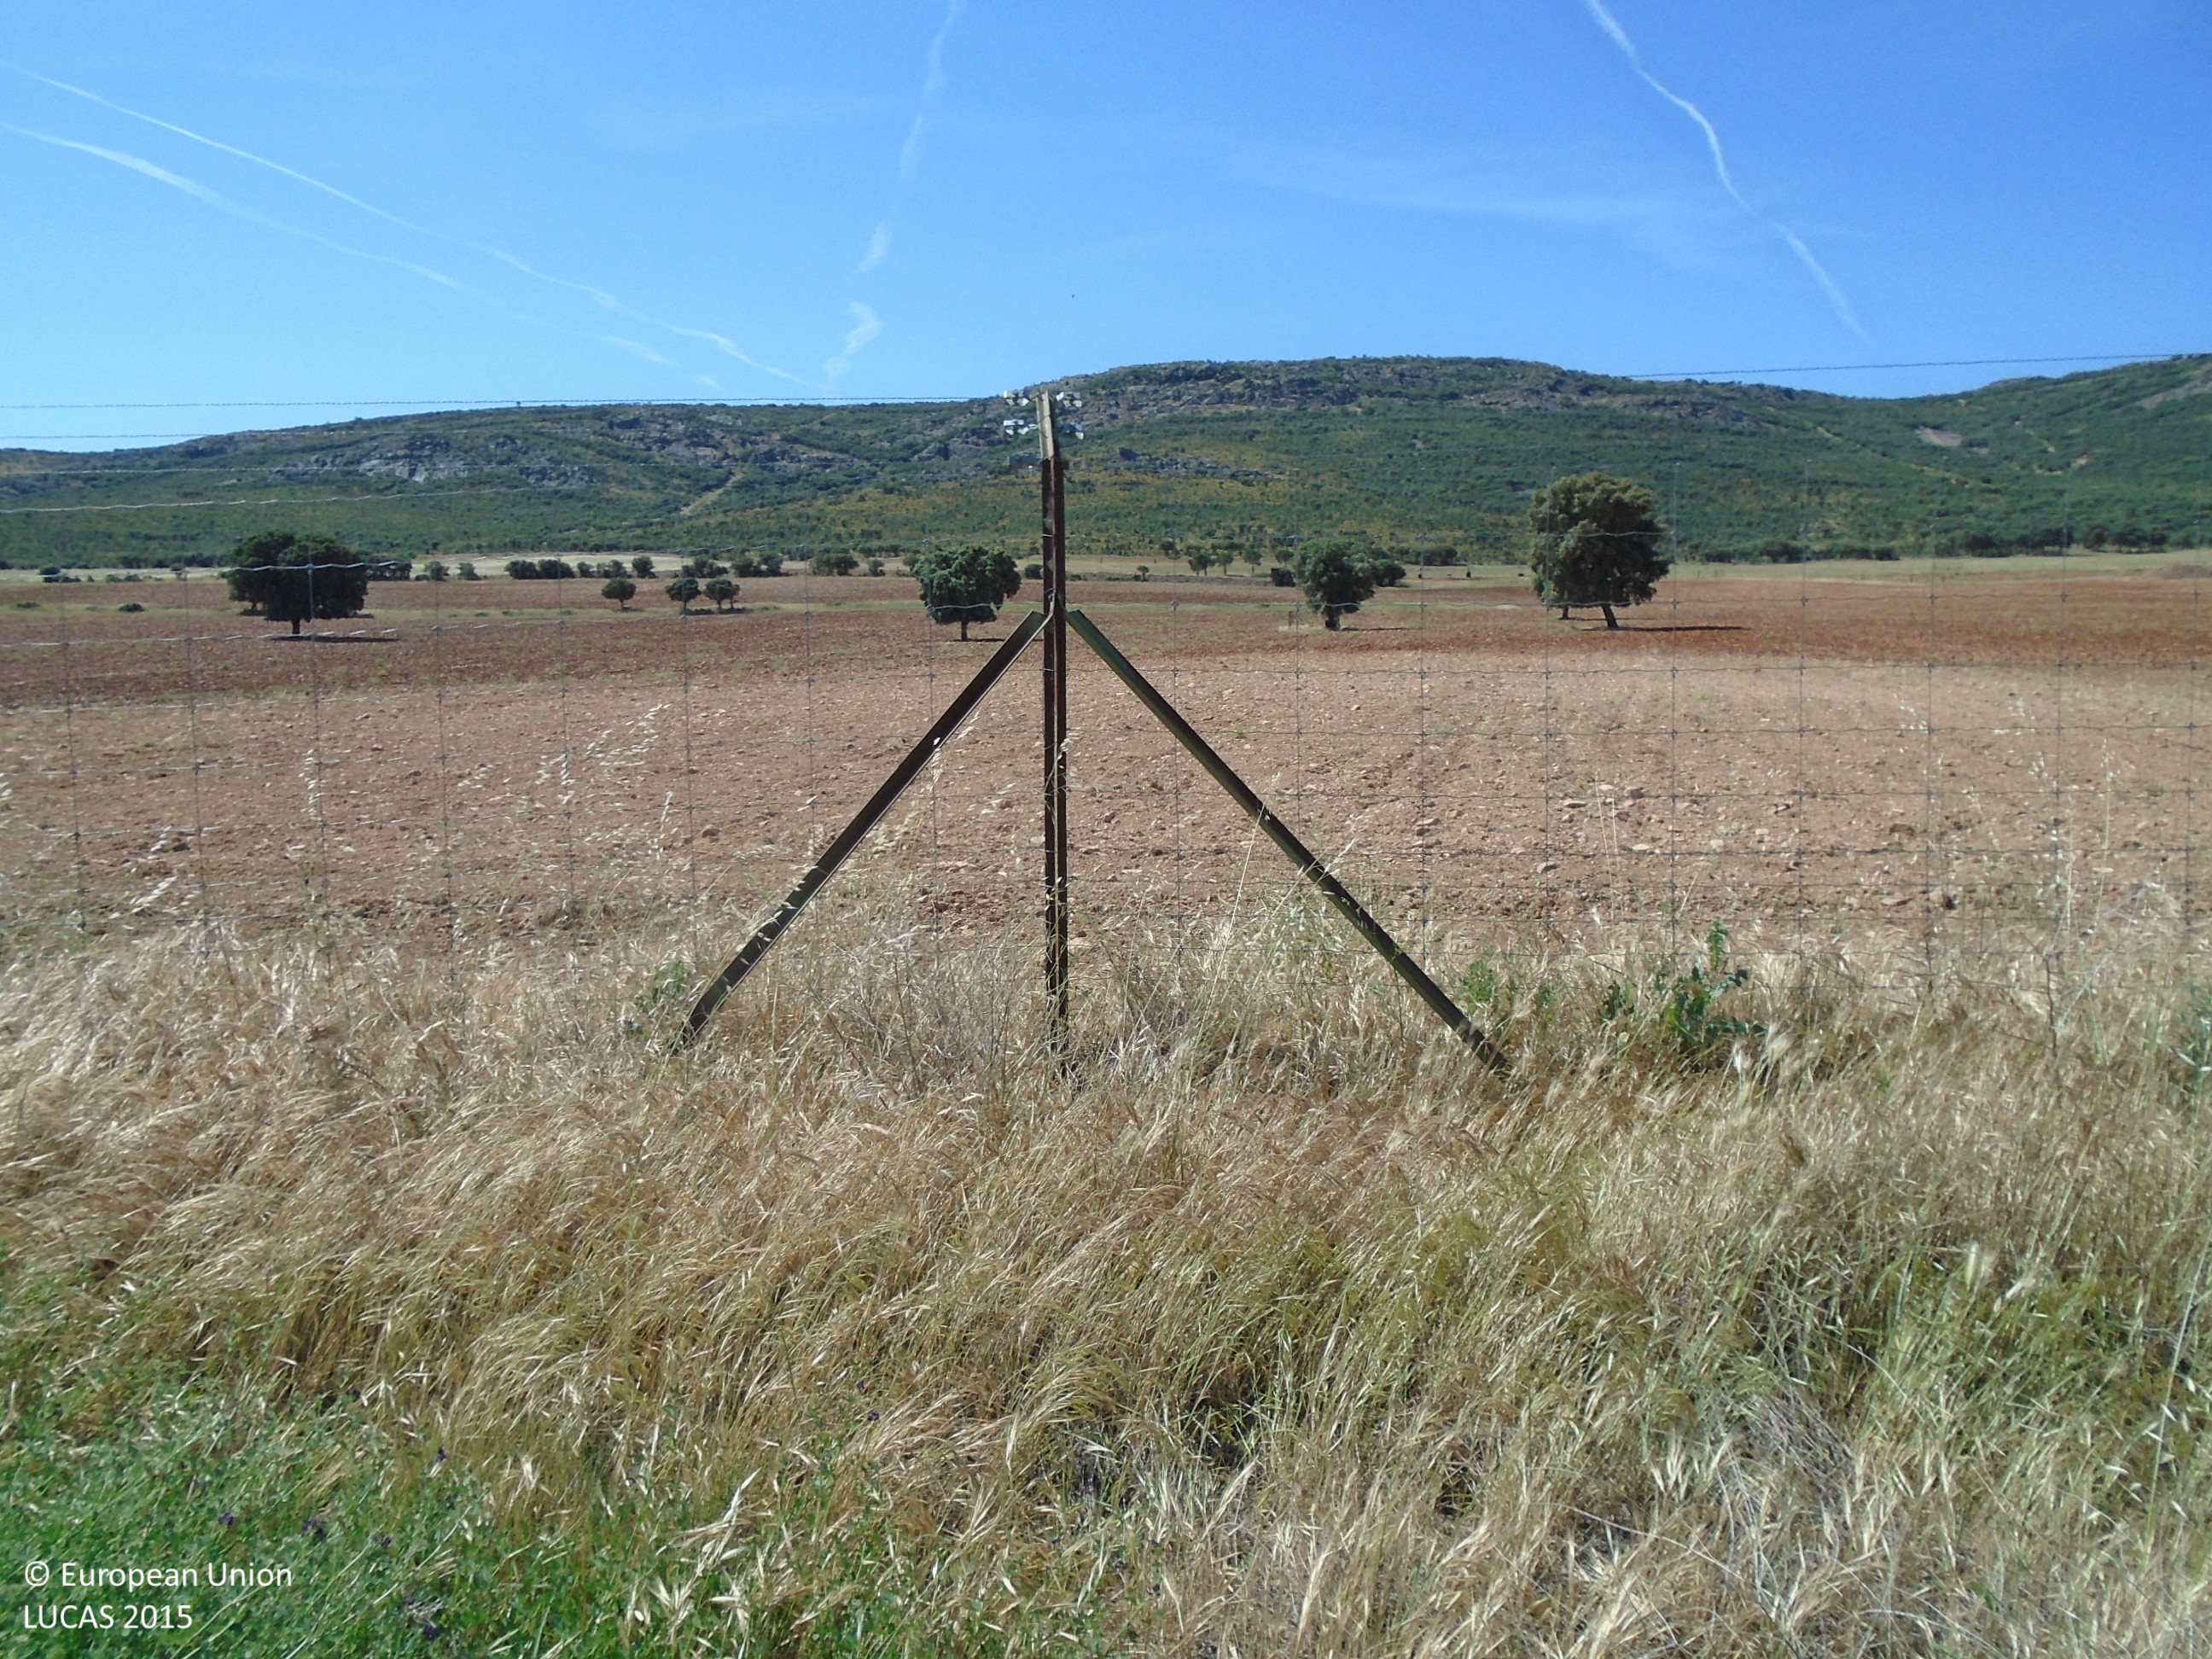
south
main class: Woodland
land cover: Broadleaved woodland
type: broadleaved evergreen forest
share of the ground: > 75 %
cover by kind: broadleaved forest trees 60 %, shrubs 30 %, herbaceous plants 5 %, consolidated bare surface 5 %
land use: Other primary production
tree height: > 5 m
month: May
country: ES
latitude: 39.4622
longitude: -3.7280
